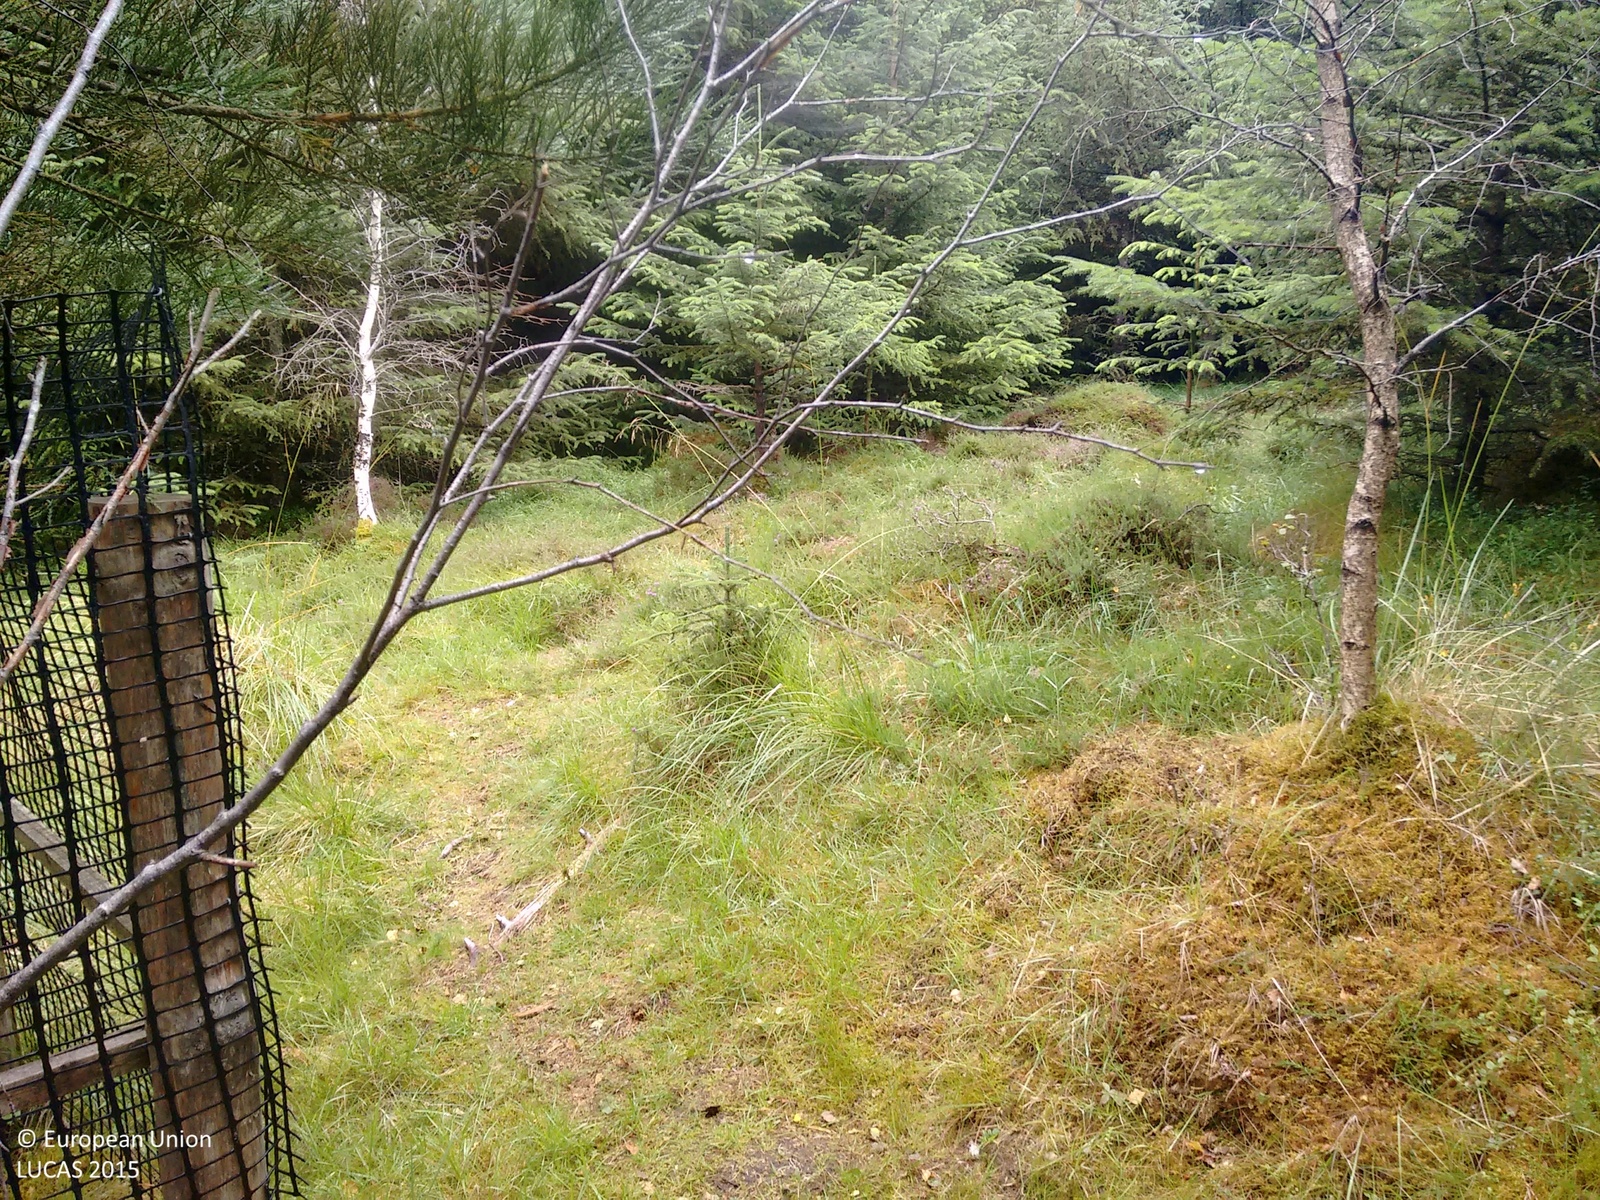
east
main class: Woodland
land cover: Spruce dominated mixed woodland
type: exotic forest
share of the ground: > 75 %
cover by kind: coniferous forest trees 60 %, broadleaved forest trees 30 %, herbaceous plants 10 %
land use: Forestry
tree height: > 5 m
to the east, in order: Spruce dominated mixed woodland; Spruce dominated coniferous woodland; Tracks; Spruce dominated coniferous woodland
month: August
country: GB
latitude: 57.4782
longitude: -2.7823
